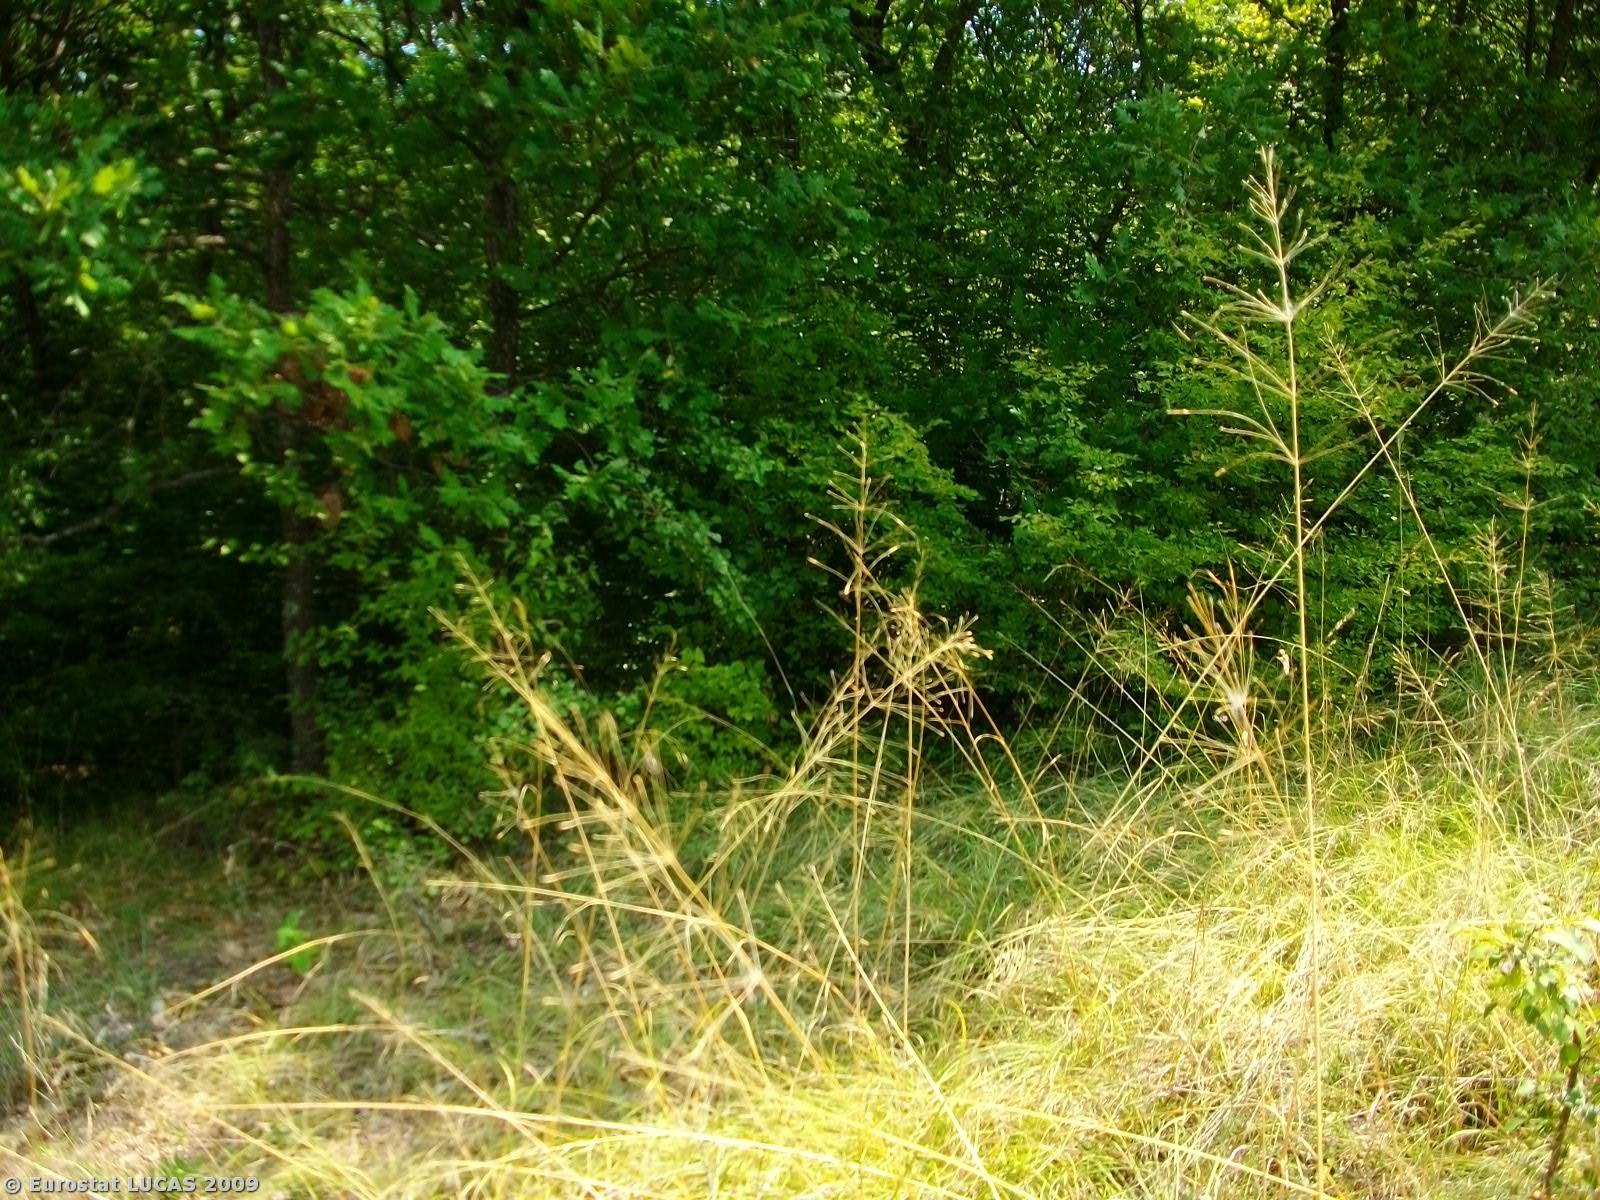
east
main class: Woodland
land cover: Broadleaved woodland
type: thermophilous deciduous forest
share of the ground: 50 - 75 %
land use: Unused
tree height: > 5 m
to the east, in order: Broadleaved woodland; Grassland with sparse tree/shrub cover; Broadleaved woodland; Spontaneously vegetated surfaces; Broadleaved woodland; Spontaneously vegetated surfaces
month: July
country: GR
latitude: 41.0605
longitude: 23.0189
